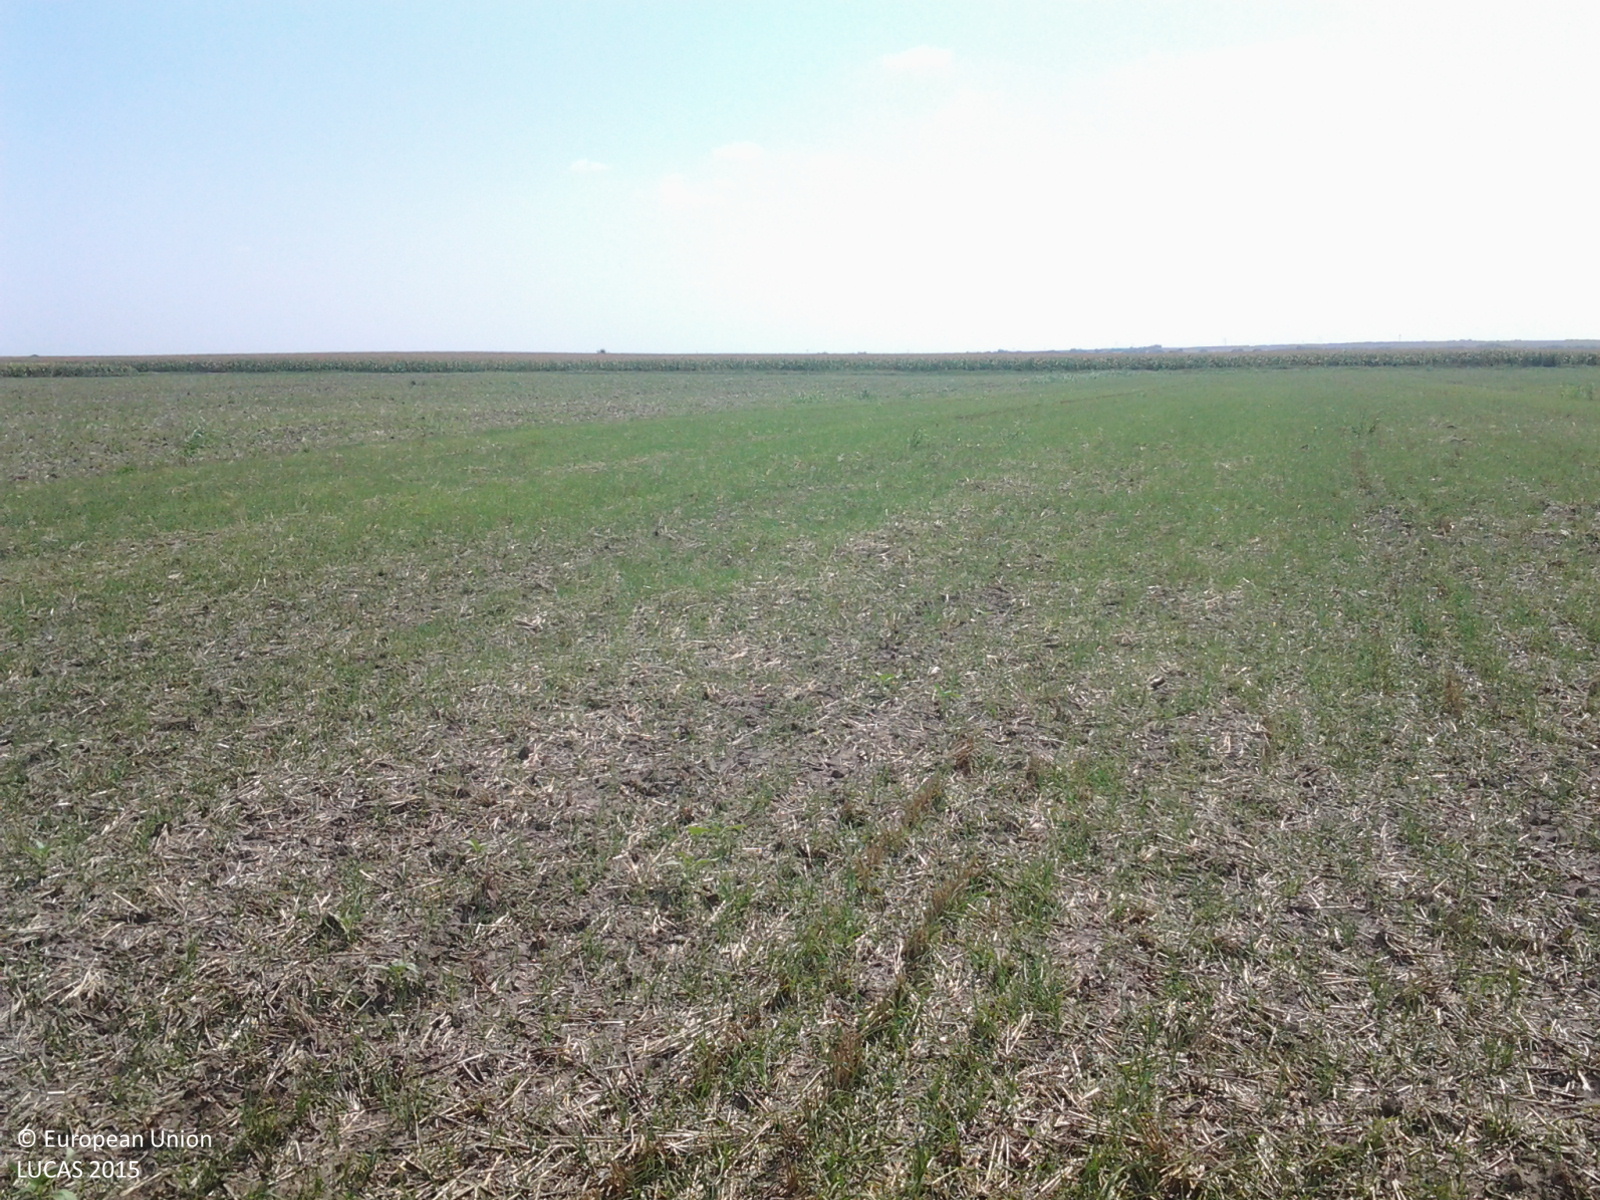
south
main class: Cropland
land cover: Common wheat
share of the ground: 10 - 25 %
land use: Agriculture (excluding fallow land and kitchen gardens)
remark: Harvested field
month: August
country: HU
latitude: 47.2861
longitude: 19.7140
